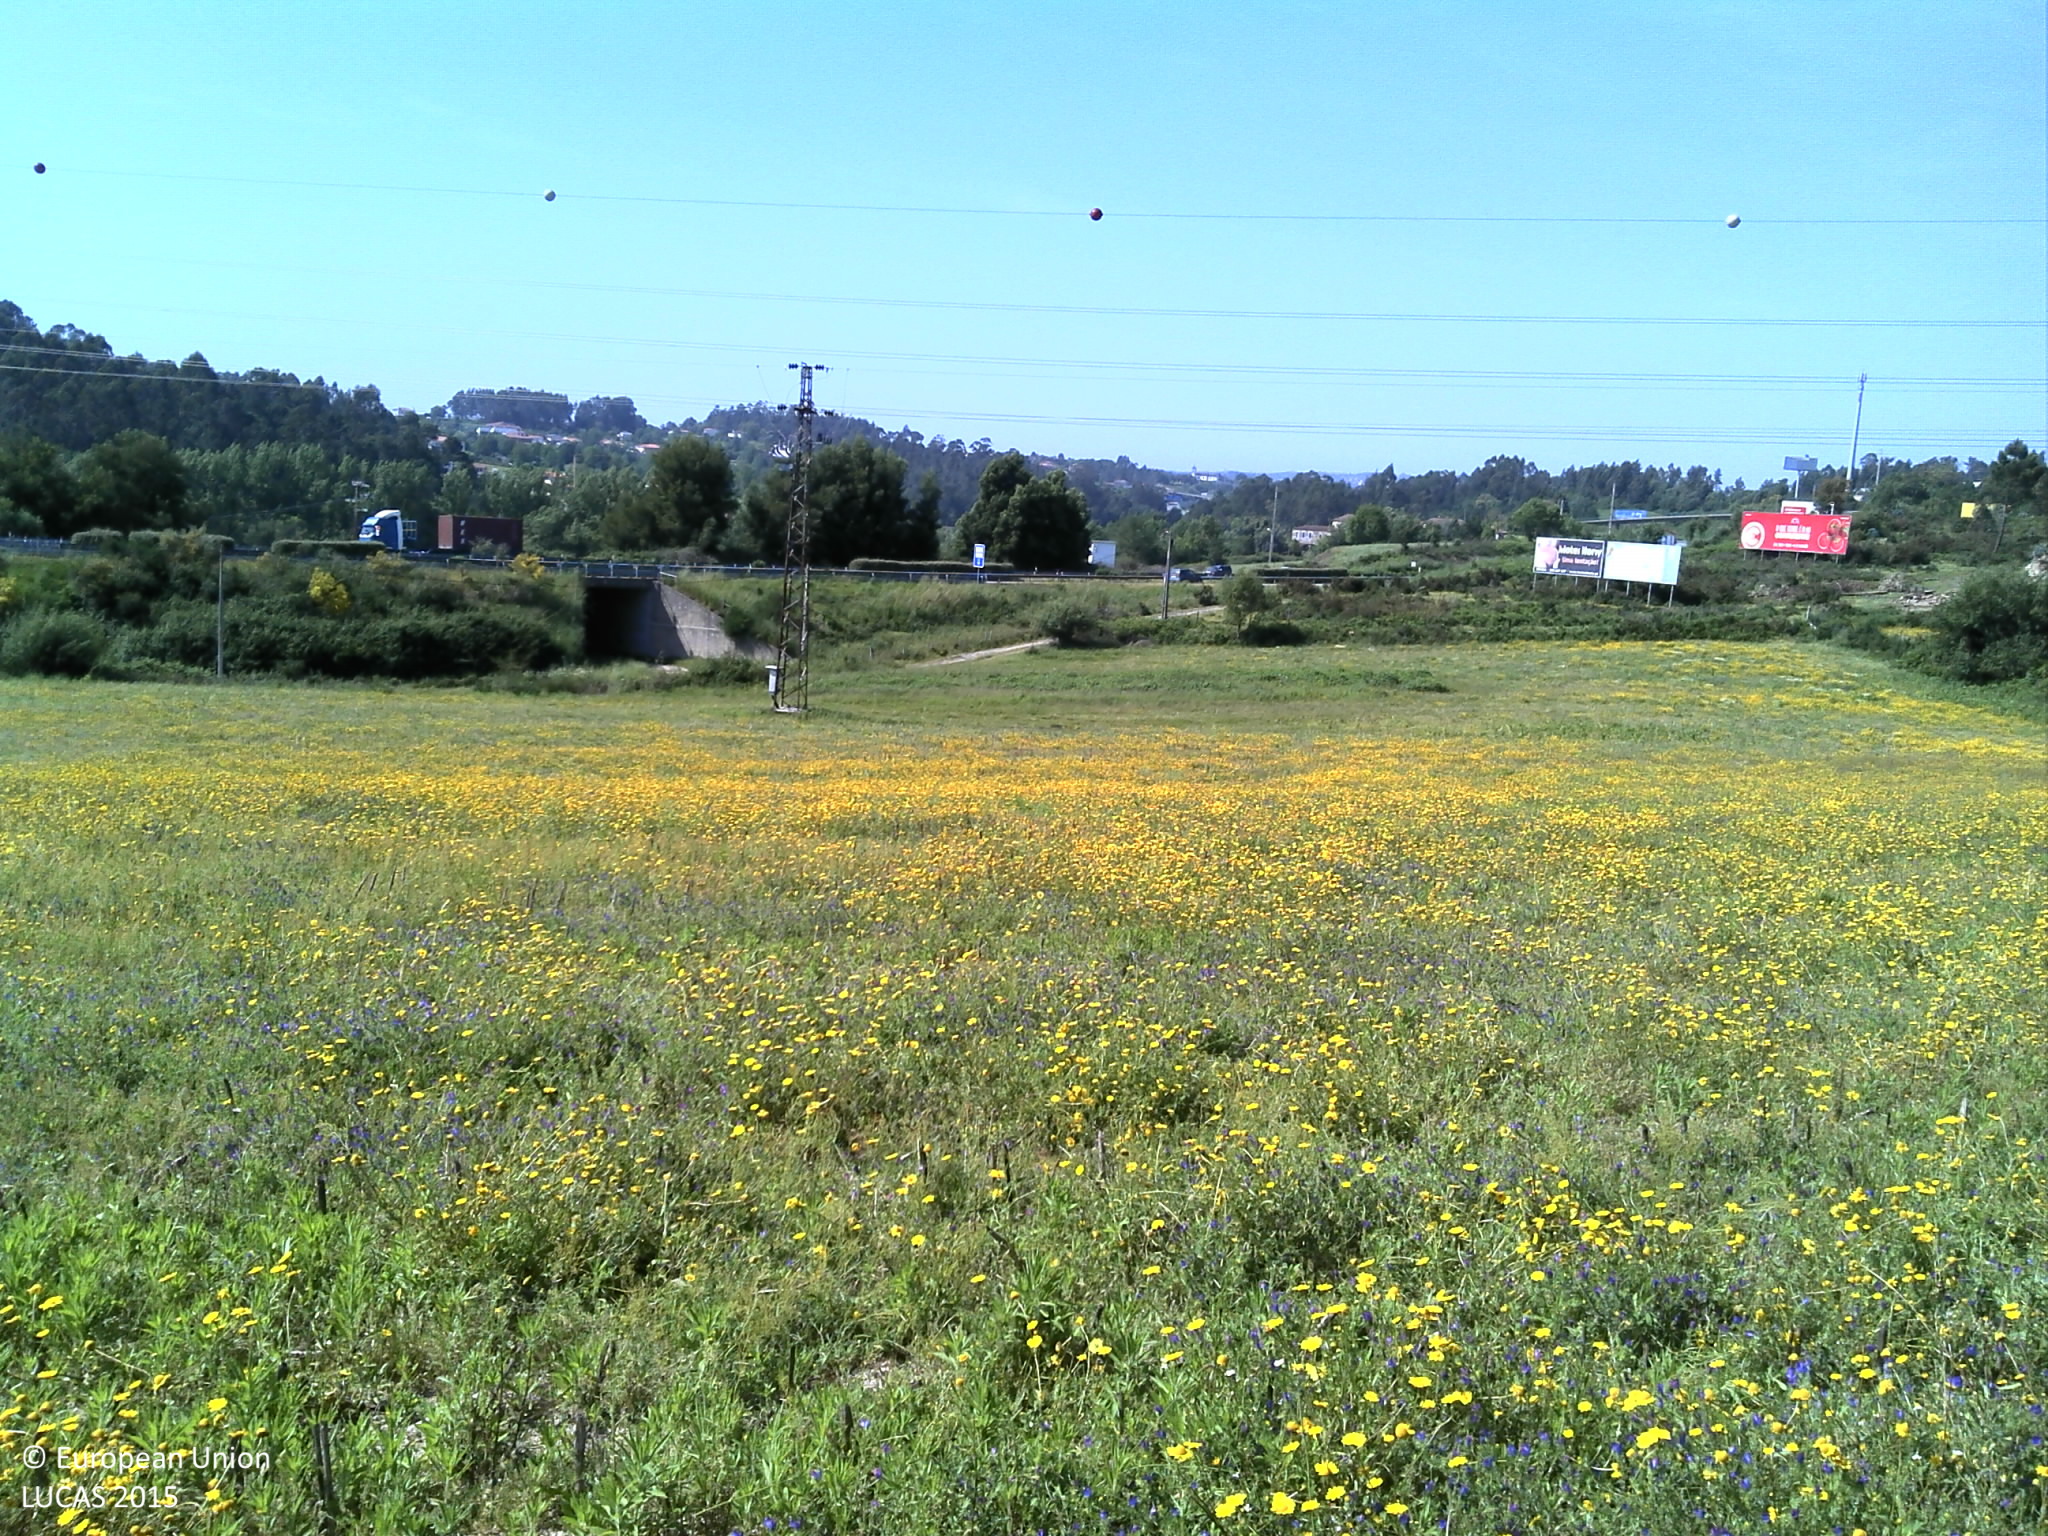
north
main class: Grassland
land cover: Grassland without tree/shrub cover
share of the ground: 50 - 75 %
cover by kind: herbaceous plants 95 %, unconsolidated bare surface 5 %
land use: Agriculture (excluding fallow land and kitchen gardens)
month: May
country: PT
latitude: 41.3570
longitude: -8.5011
